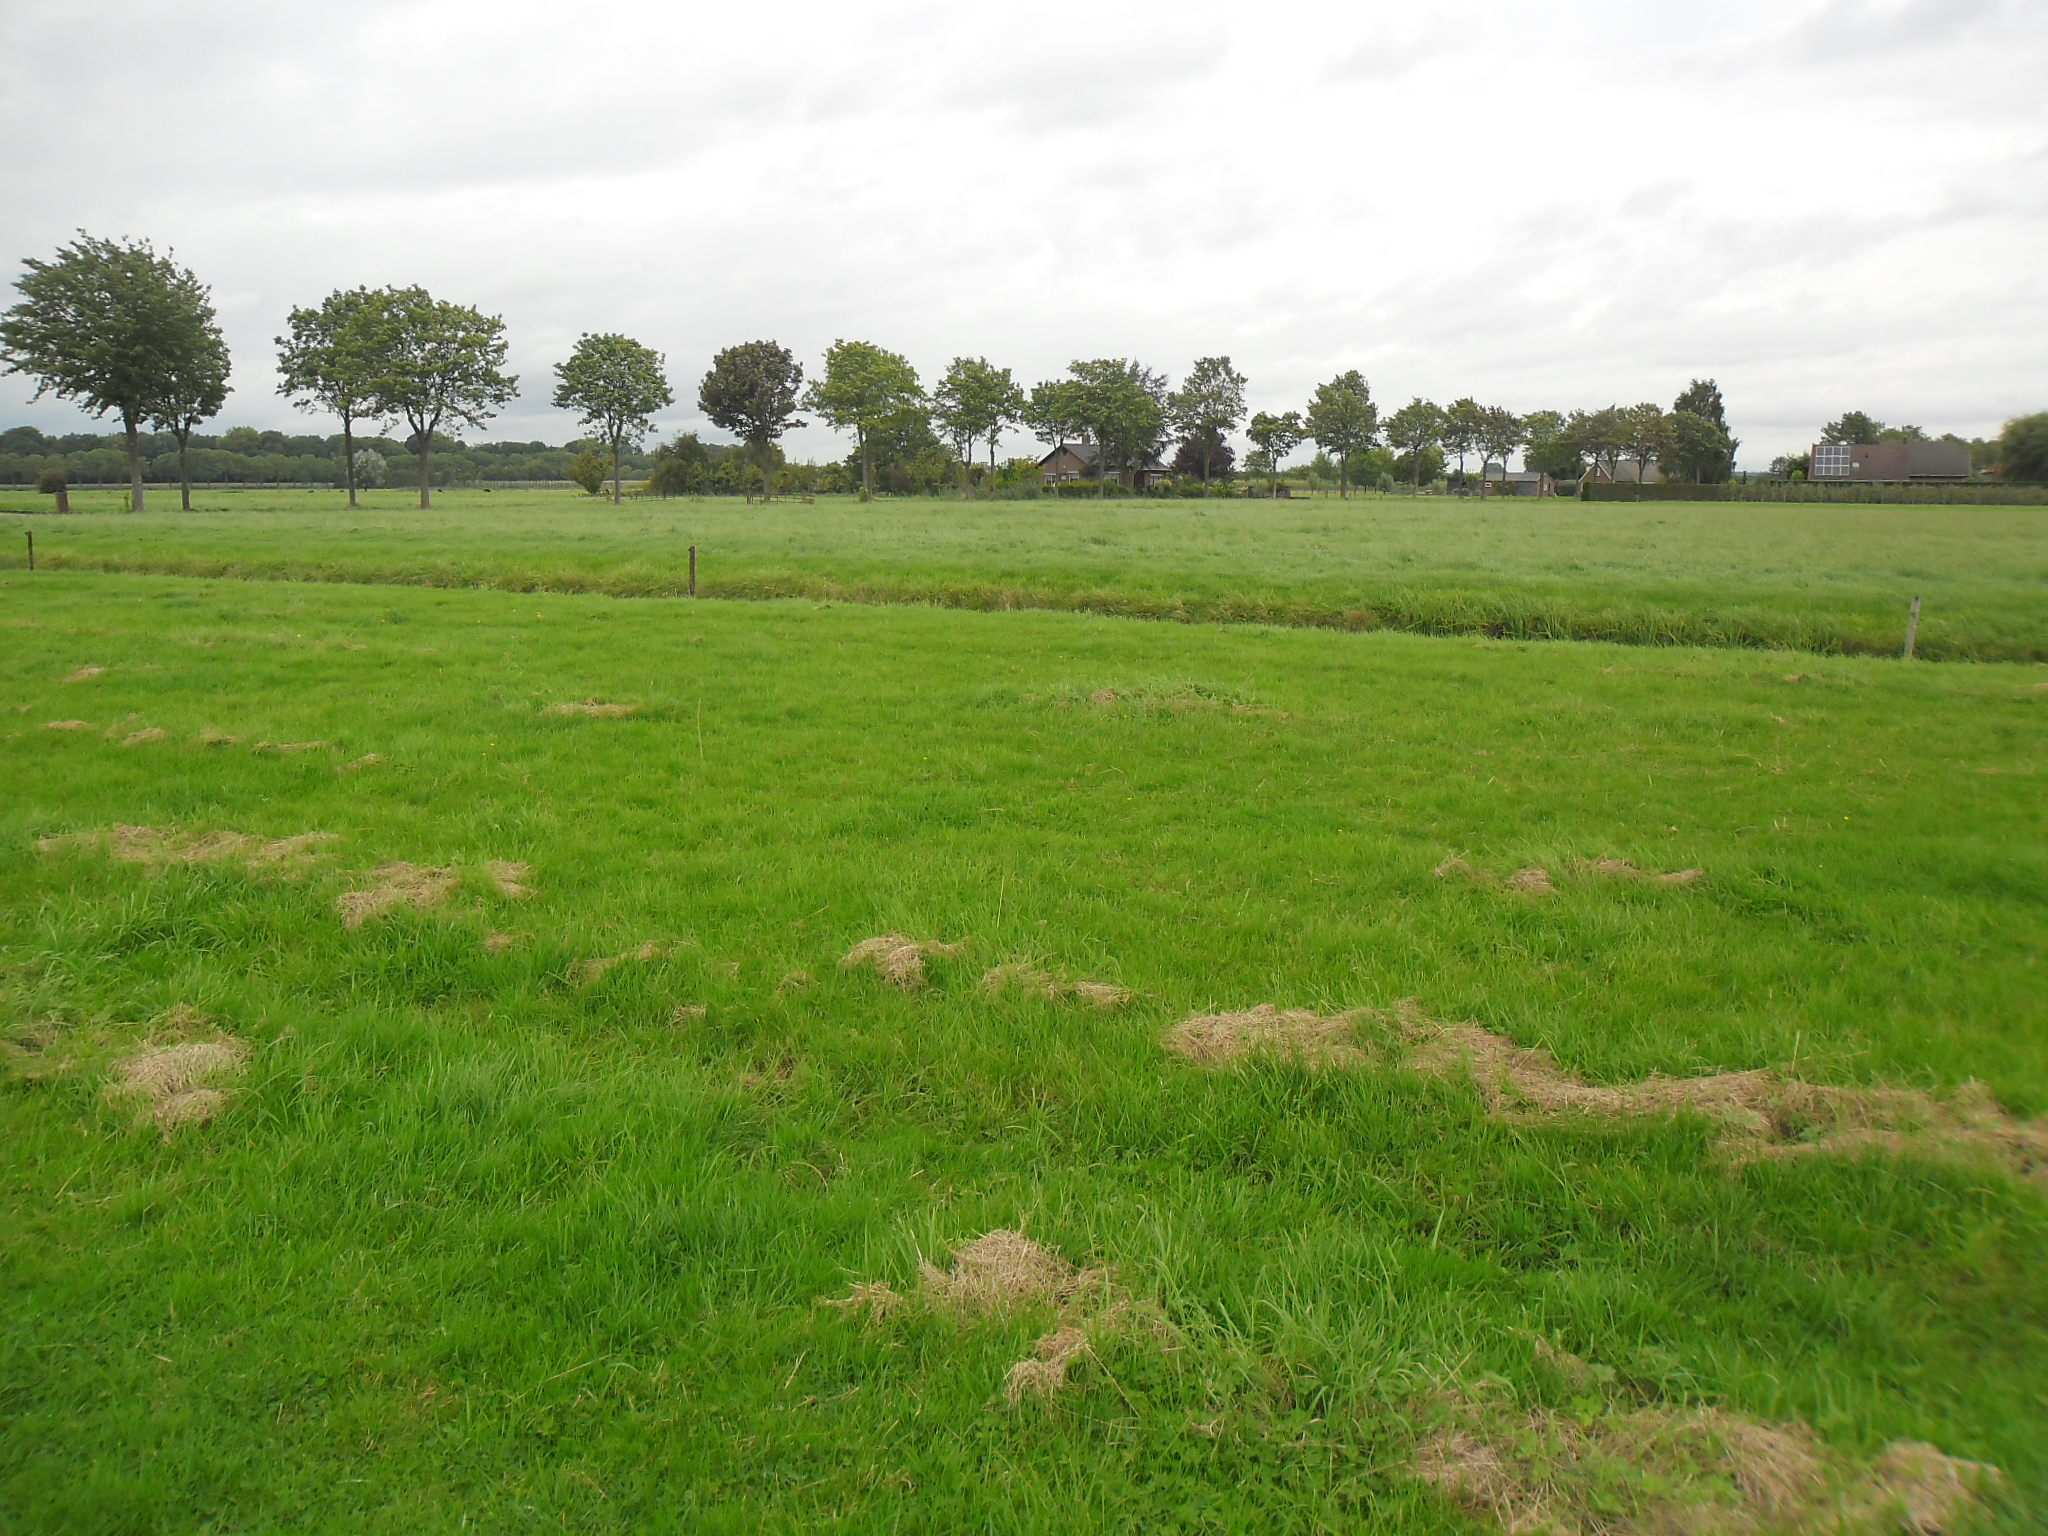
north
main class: Grassland
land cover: Grassland without tree/shrub cover
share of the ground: > 75 %
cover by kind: herbaceous plants 100 %
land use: Agriculture (excluding fallow land and kitchen gardens)
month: September
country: NL
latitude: 51.9323
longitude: 5.5042
